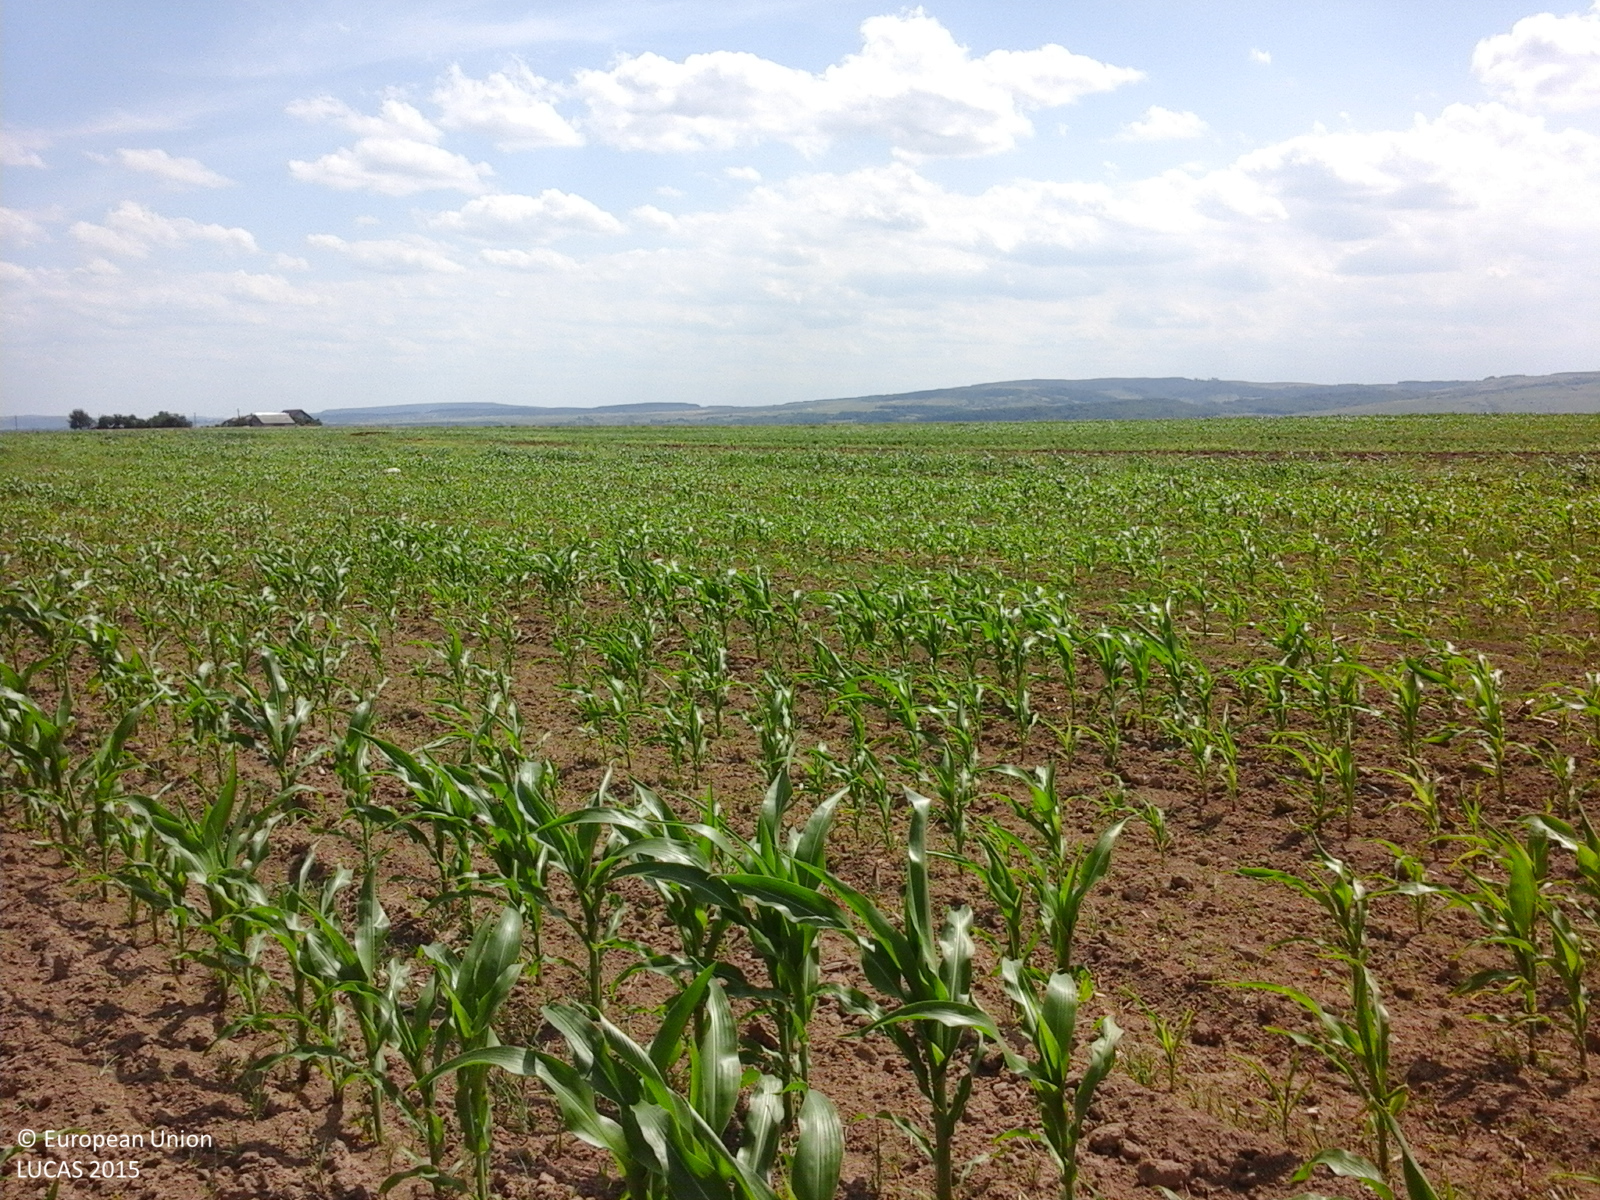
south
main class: Cropland
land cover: Maize
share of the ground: 25 - 50 %
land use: Agriculture (excluding fallow land and kitchen gardens)
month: June
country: RO
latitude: 47.6126
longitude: 26.4928
